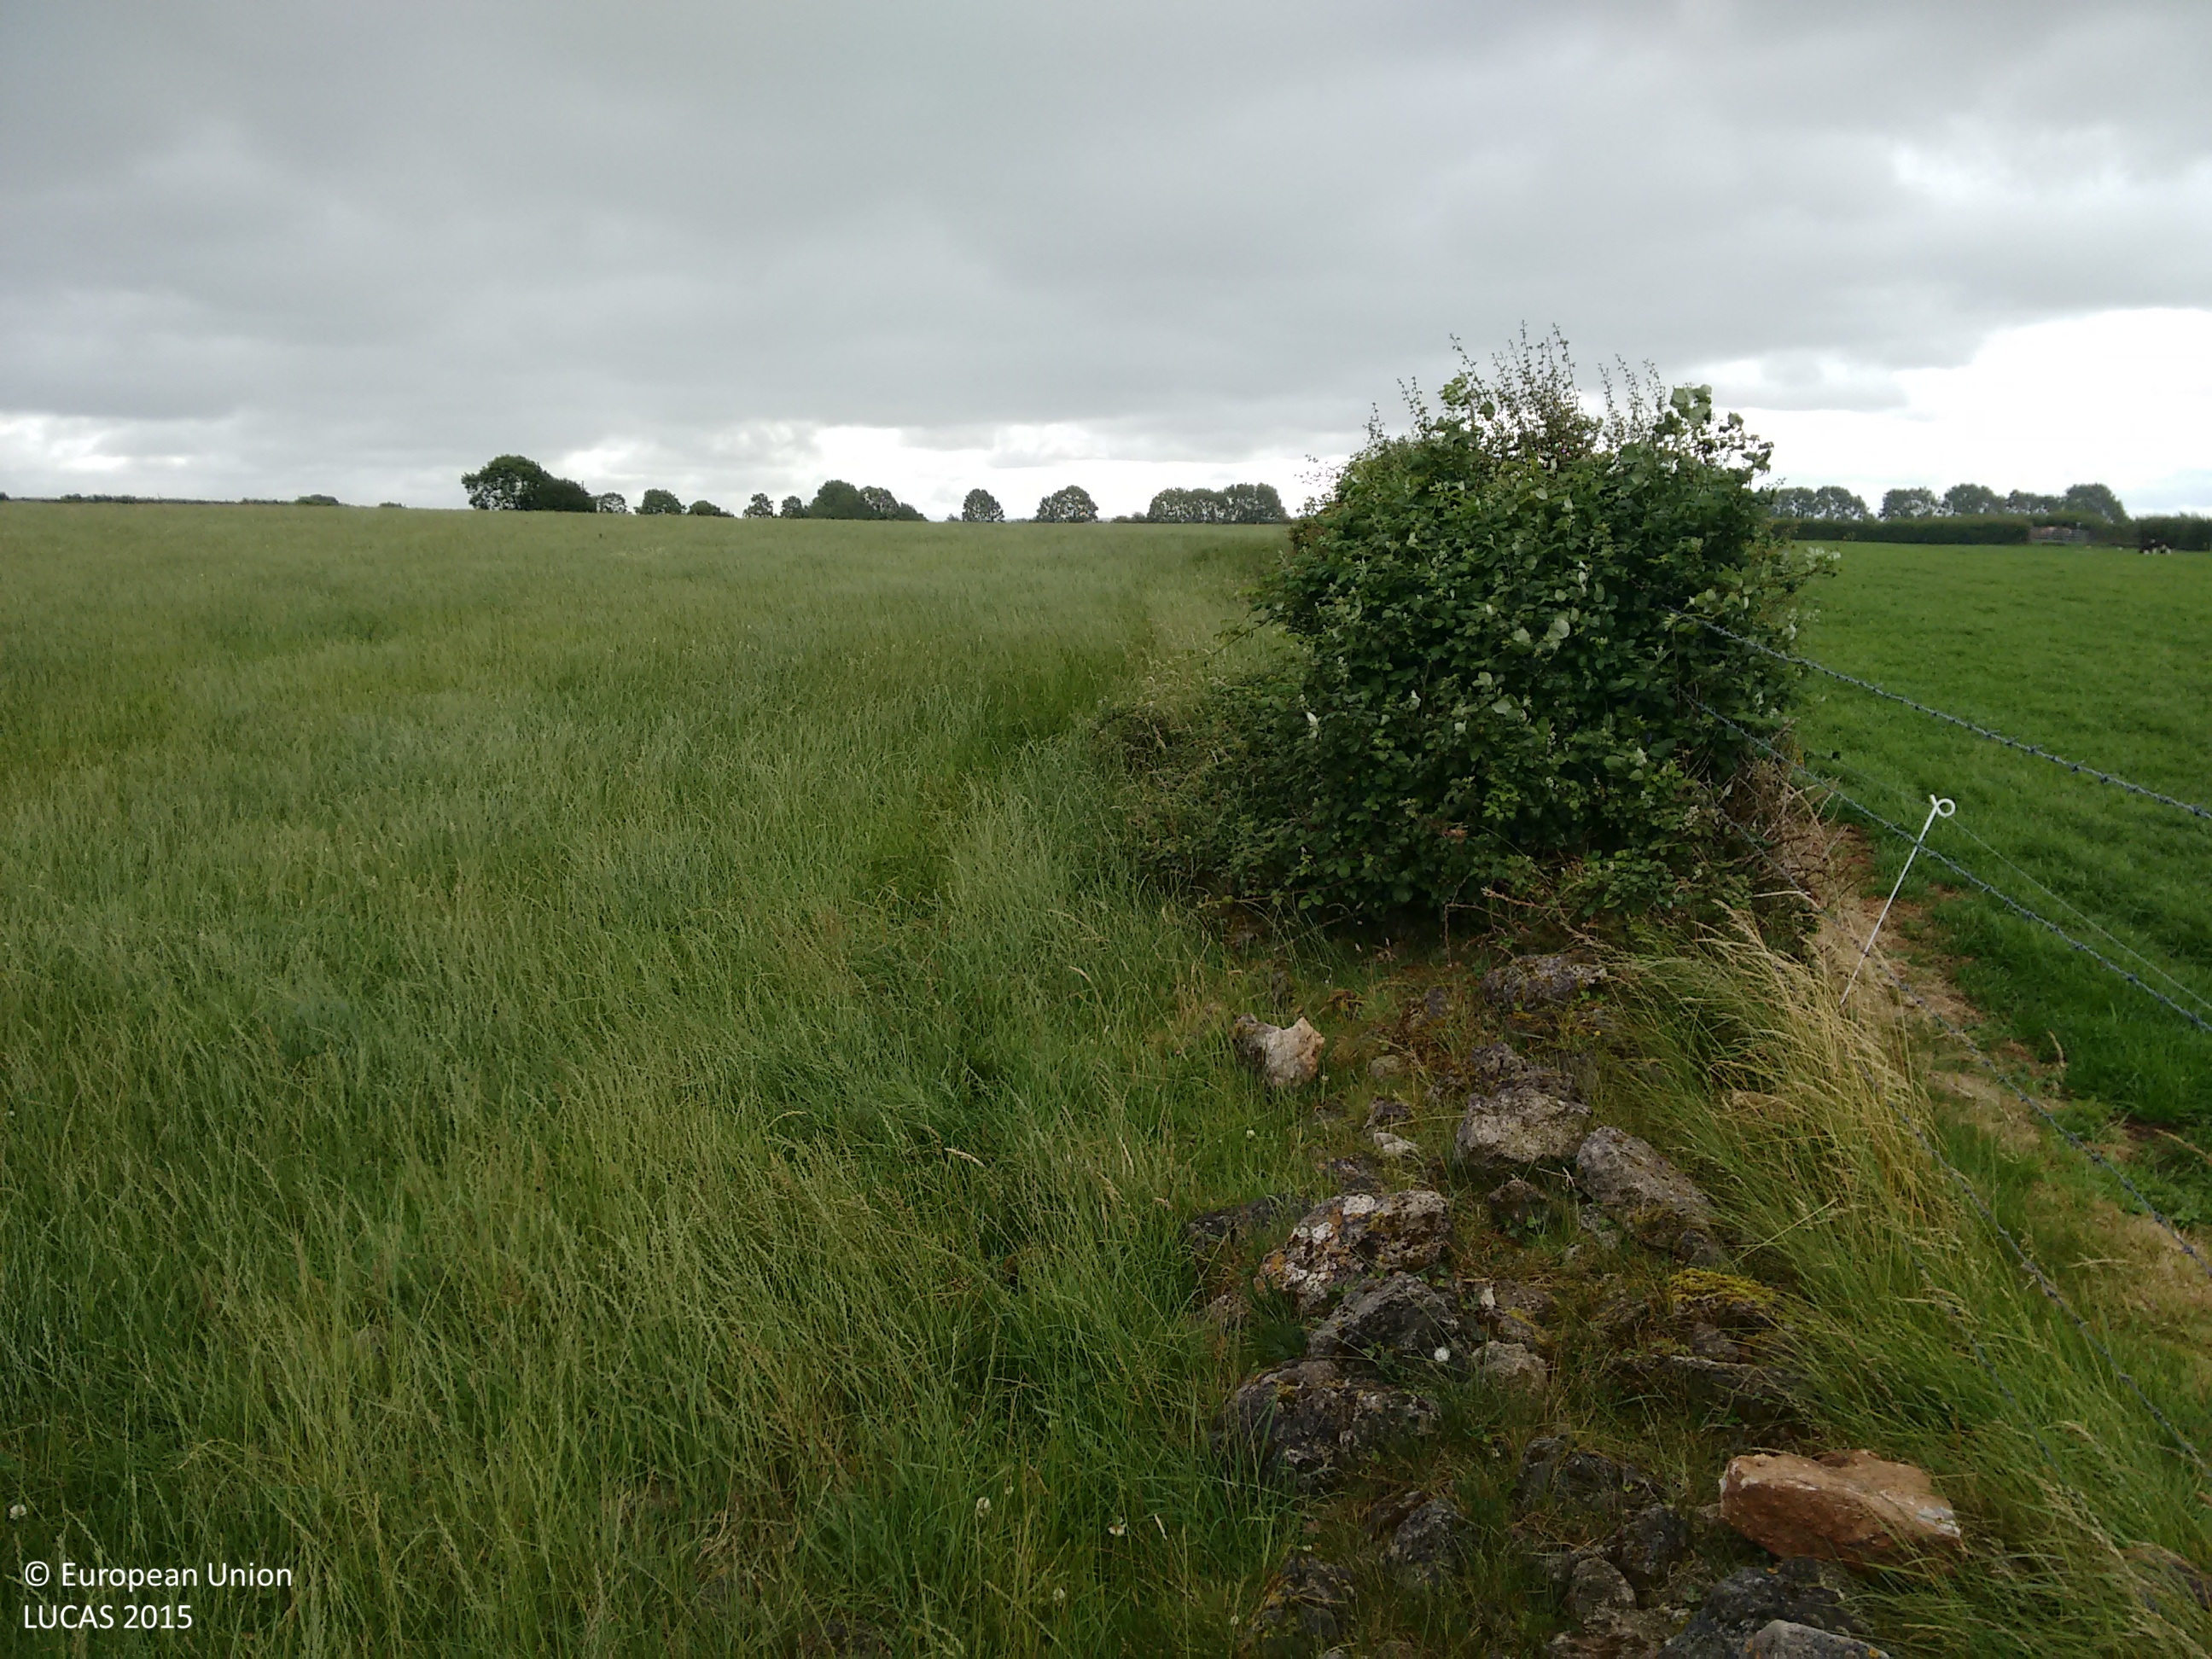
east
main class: Grassland
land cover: Grassland without tree/shrub cover
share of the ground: > 75 %
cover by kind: herbaceous plants 100 %
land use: Agriculture (excluding fallow land and kitchen gardens)
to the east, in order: Grassland without tree/shrub cover; Fences; Abandoned hedges; Grassland without tree/shrub cover
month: July
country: IE
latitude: 52.7562
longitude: -7.6327
